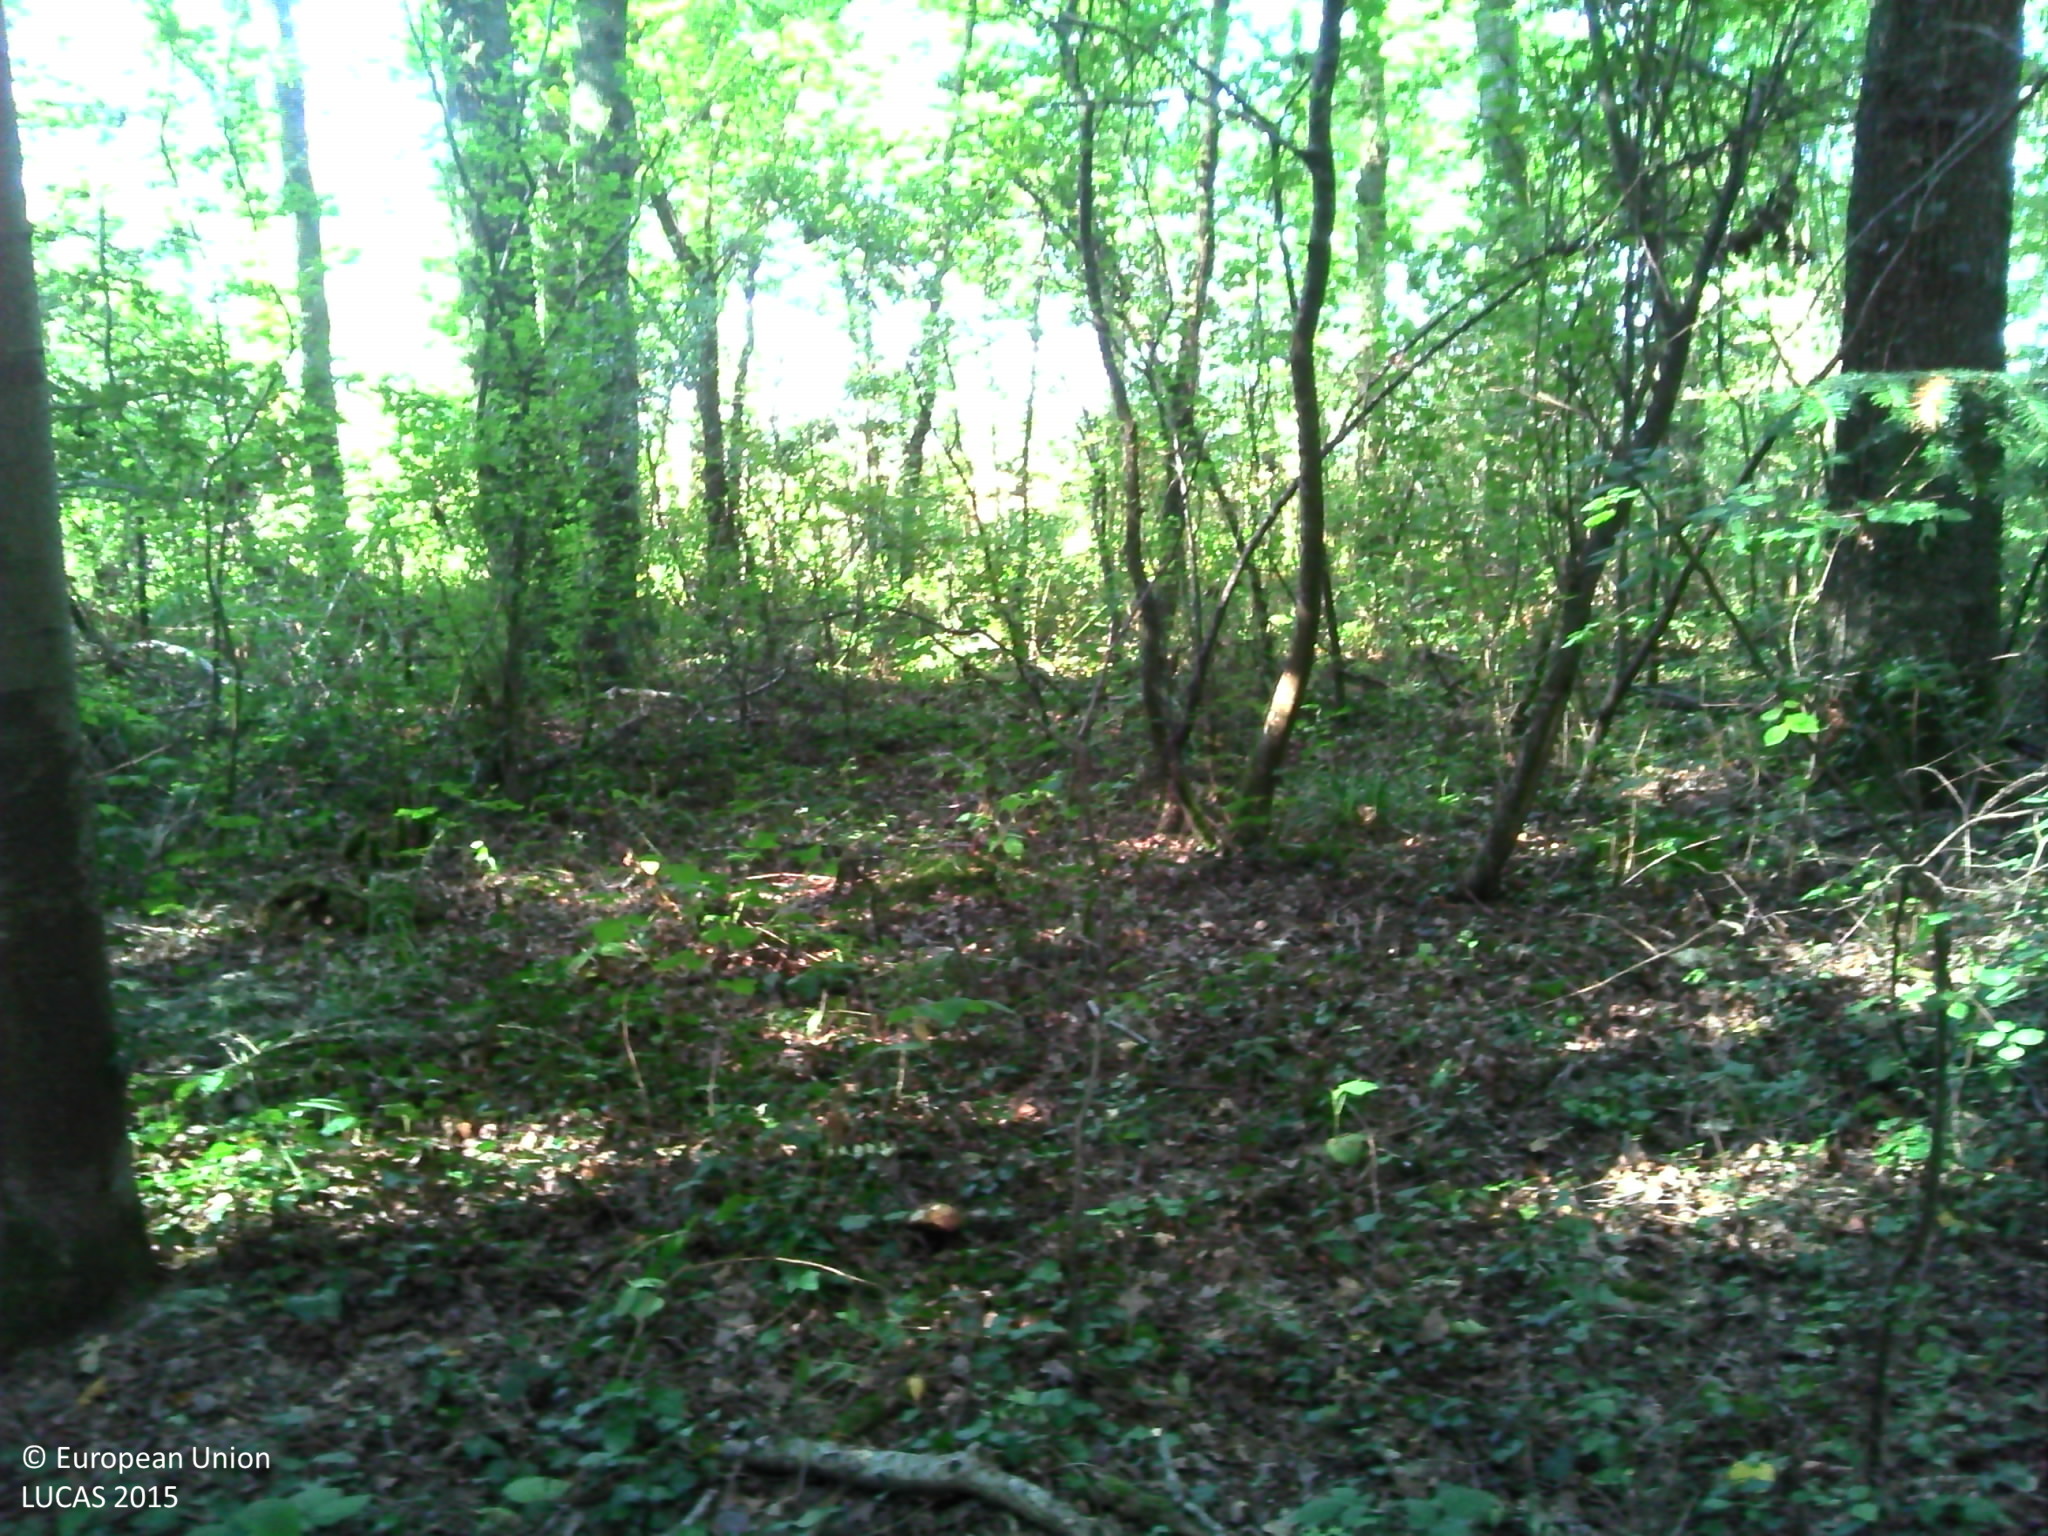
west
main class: Woodland
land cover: Spruce dominated mixed woodland
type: mesophytic deciduous forest
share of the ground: > 75 %
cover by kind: broadleaved forest trees 70 %, coniferous forest trees 30 %
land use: Forestry
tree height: > 5 m
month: October
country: FR
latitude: 48.1819
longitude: 4.2540
